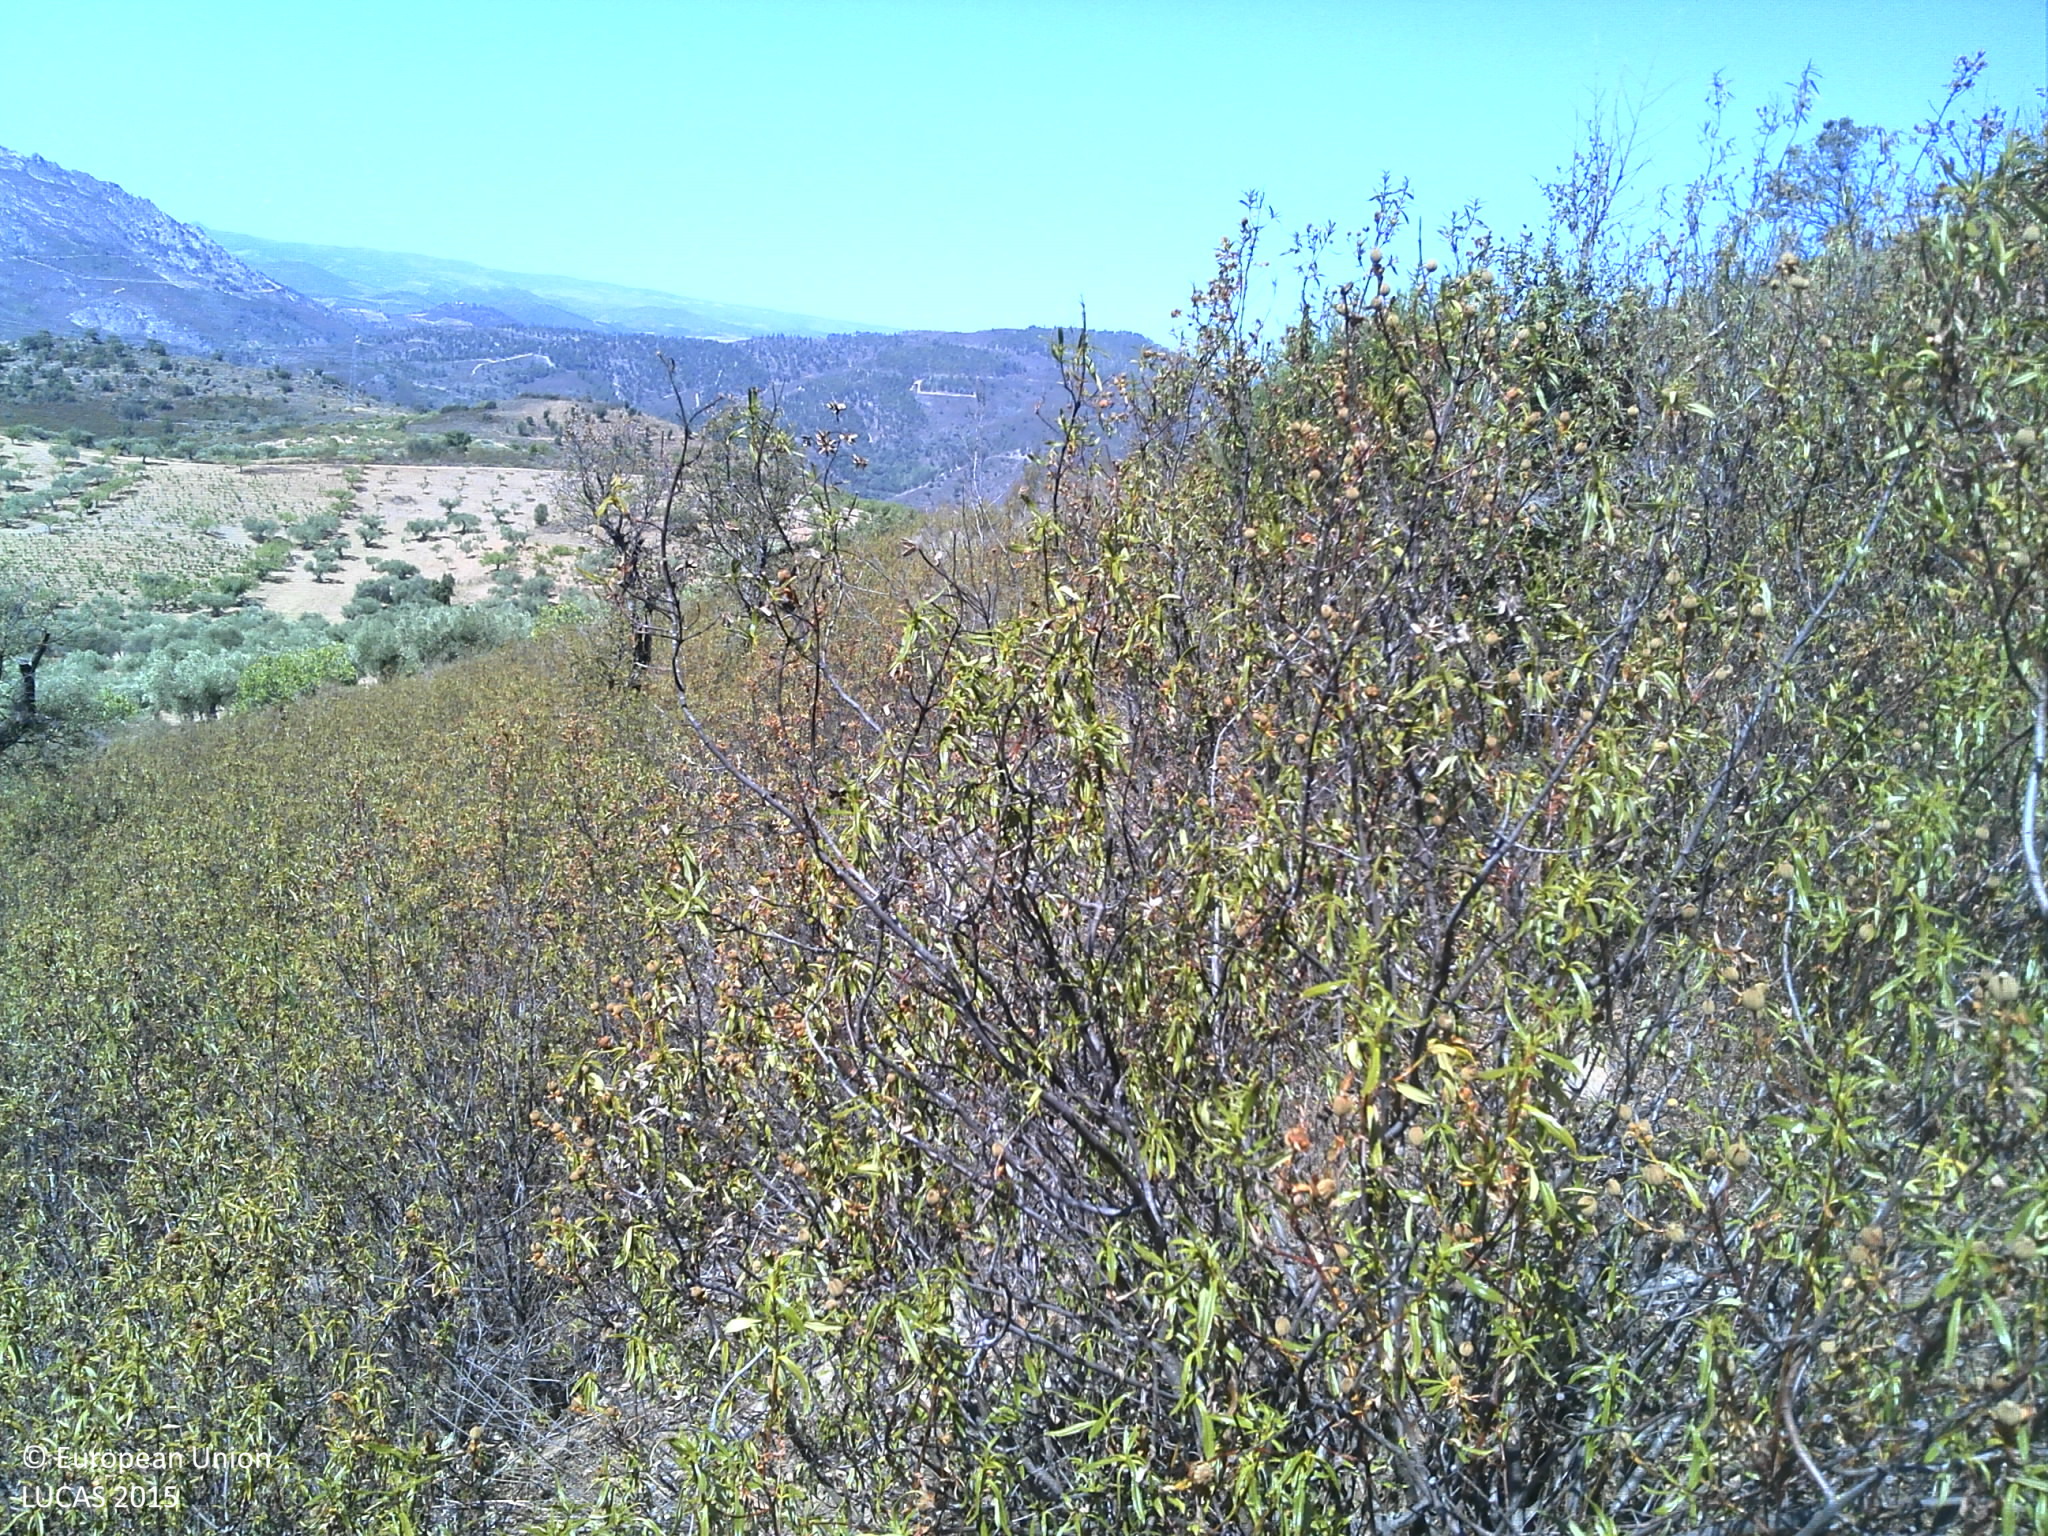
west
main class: Shrubland
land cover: Shrubland with sparse tree cover
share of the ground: > 75 %
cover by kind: shrubs 95 %, broadleaved forest trees 5 %
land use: Semi-natural and natural areas not in use
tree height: > 5 m
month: July
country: PT
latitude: 41.4016
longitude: -7.1375
